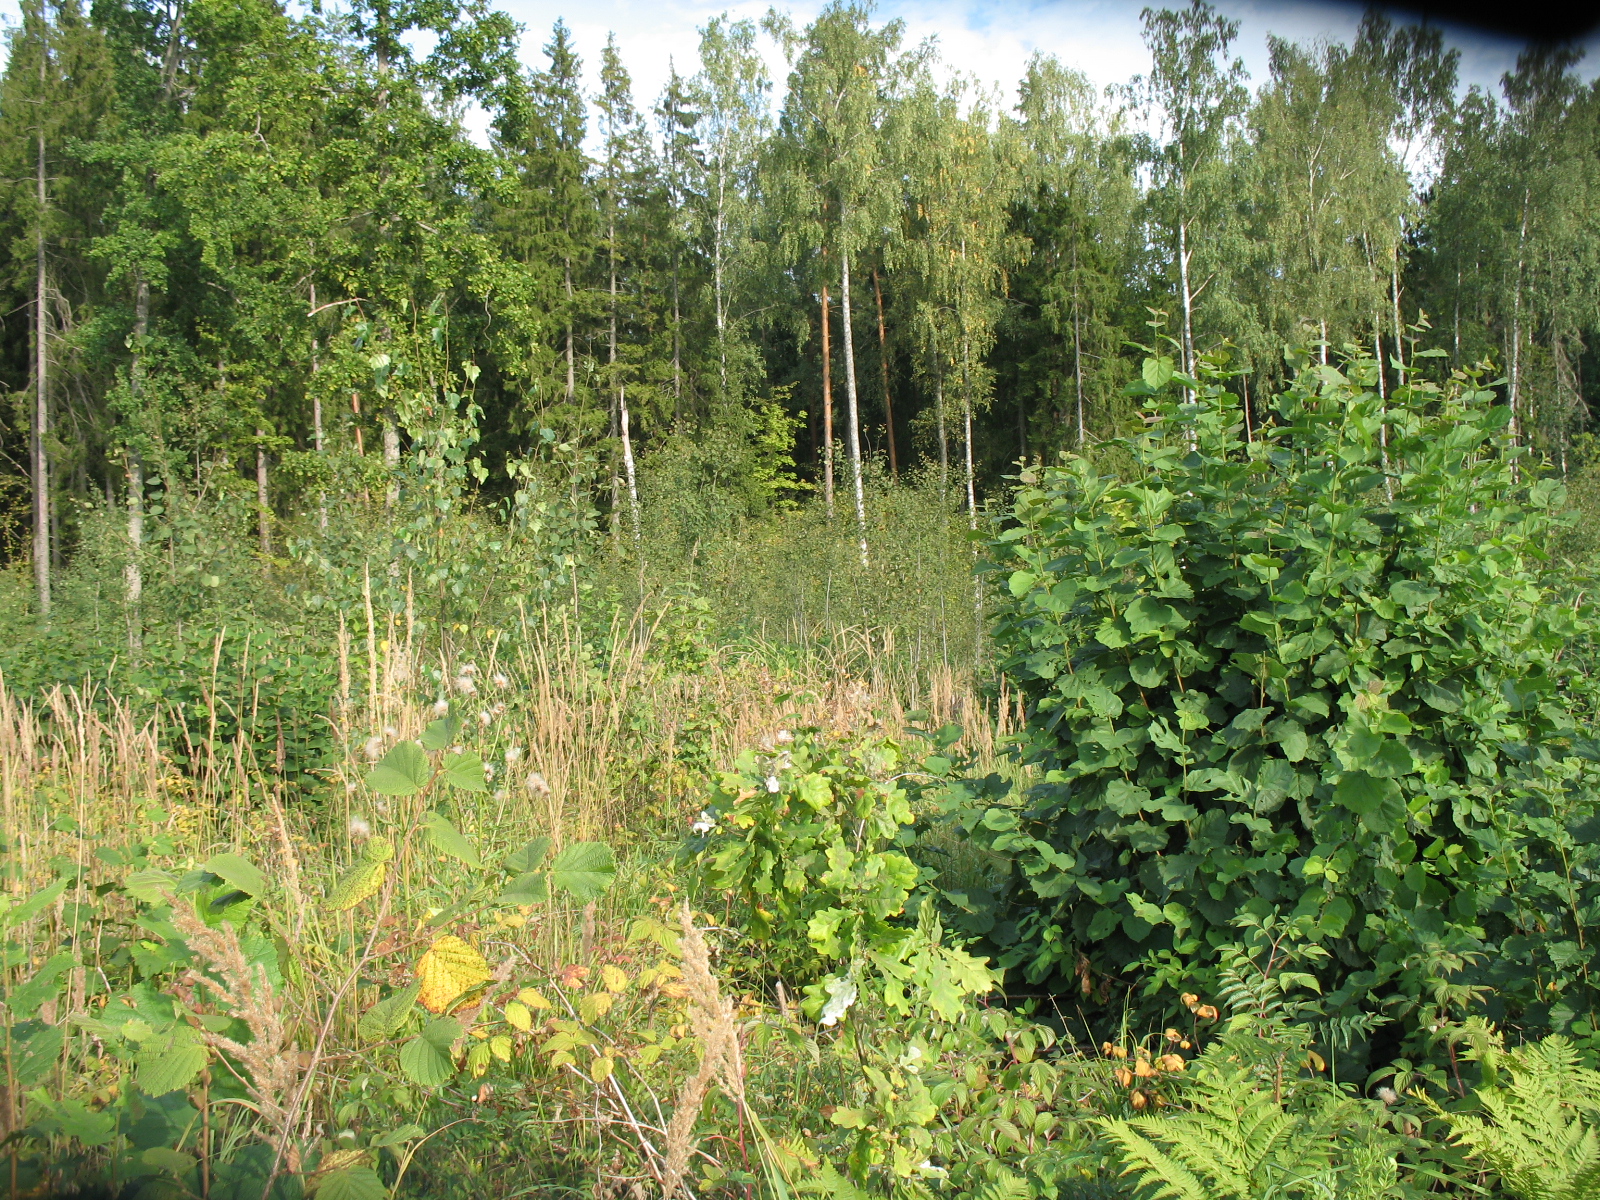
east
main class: Woodland
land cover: Broadleaved woodland
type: non-riverine alder, birch or aspen forest
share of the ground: 10 - 25 %
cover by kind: herbaceous plants 60 %, broadleaved forest trees 20 %, shrubs 20 %
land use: Forestry
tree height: < 5 m
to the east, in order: Broadleaved woodland; Other mixed woodland
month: August
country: LV
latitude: 56.3128
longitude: 25.5609
